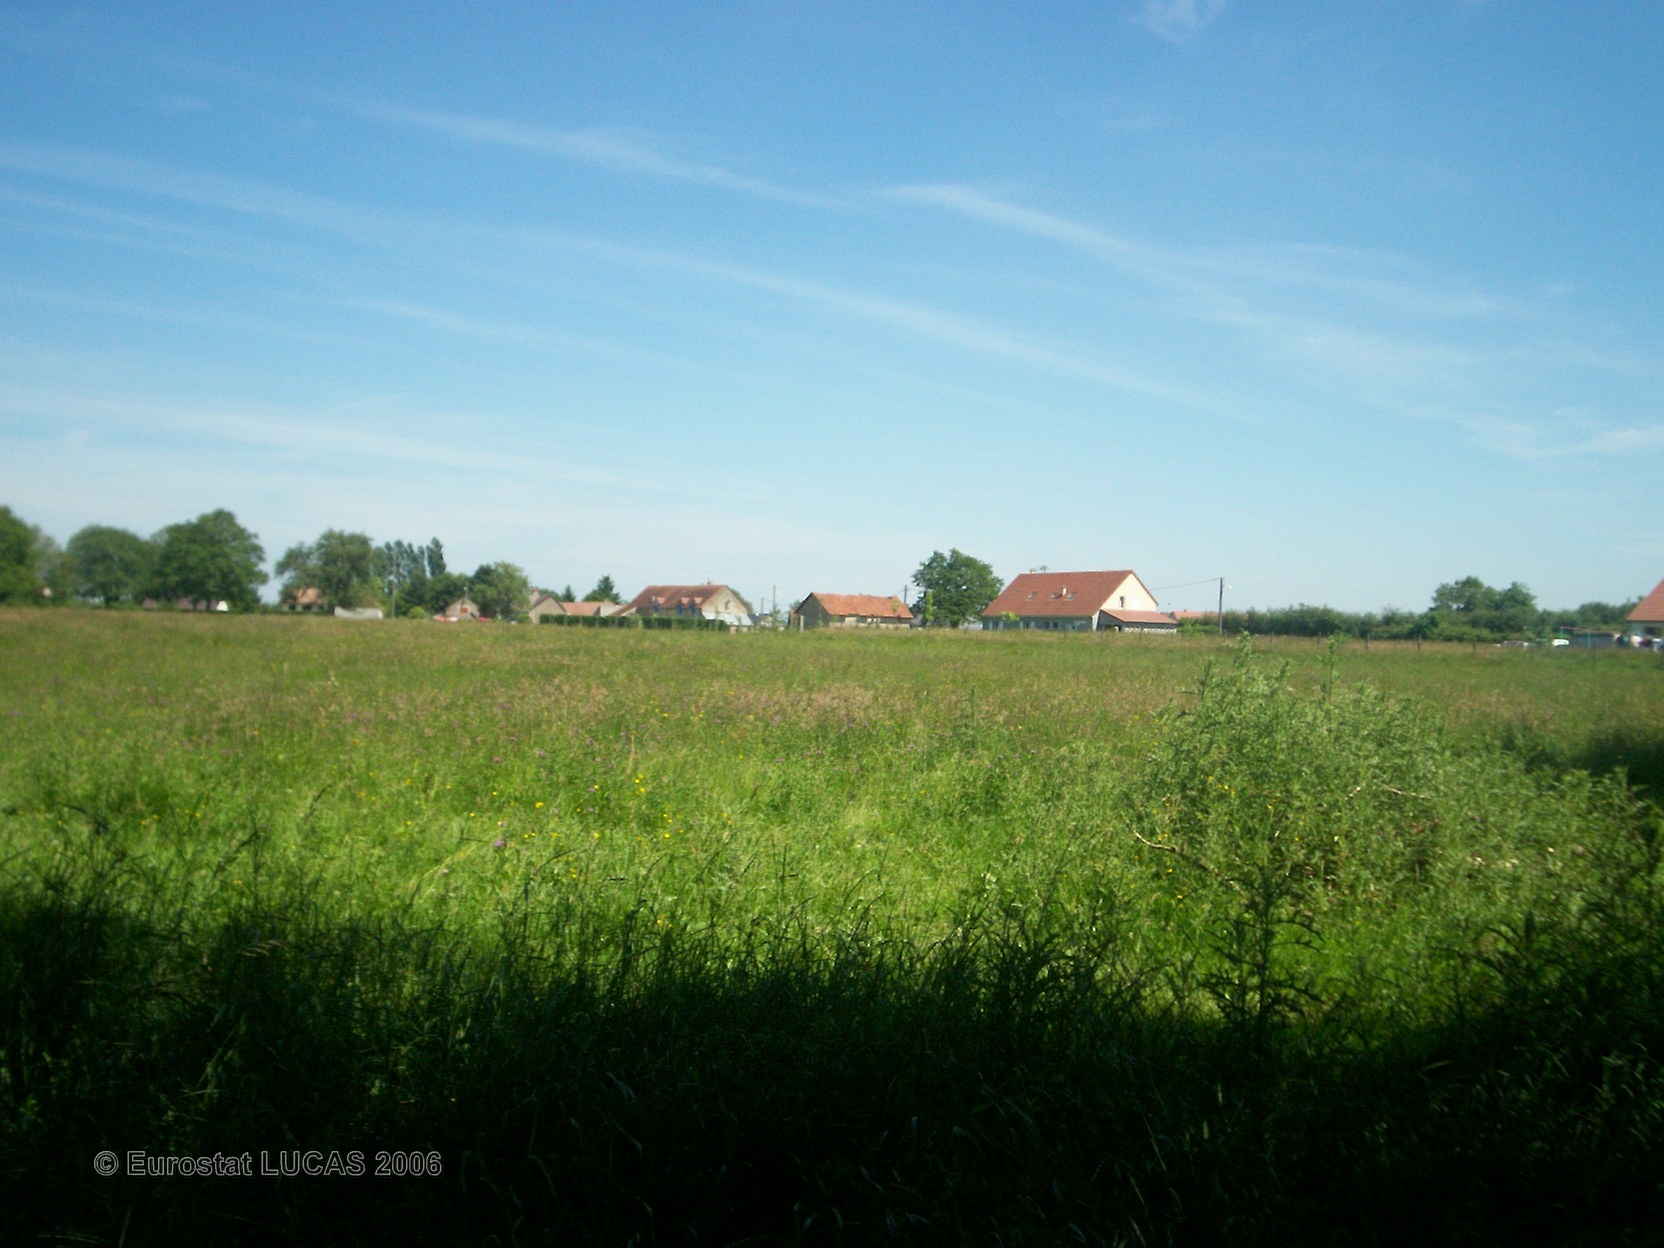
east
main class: Grassland
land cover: Grassland with sparse tree/shrub cover
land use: Agriculture (excluding fallow land and kitchen gardens)
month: June
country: FR
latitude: 46.9560
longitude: 3.0447
